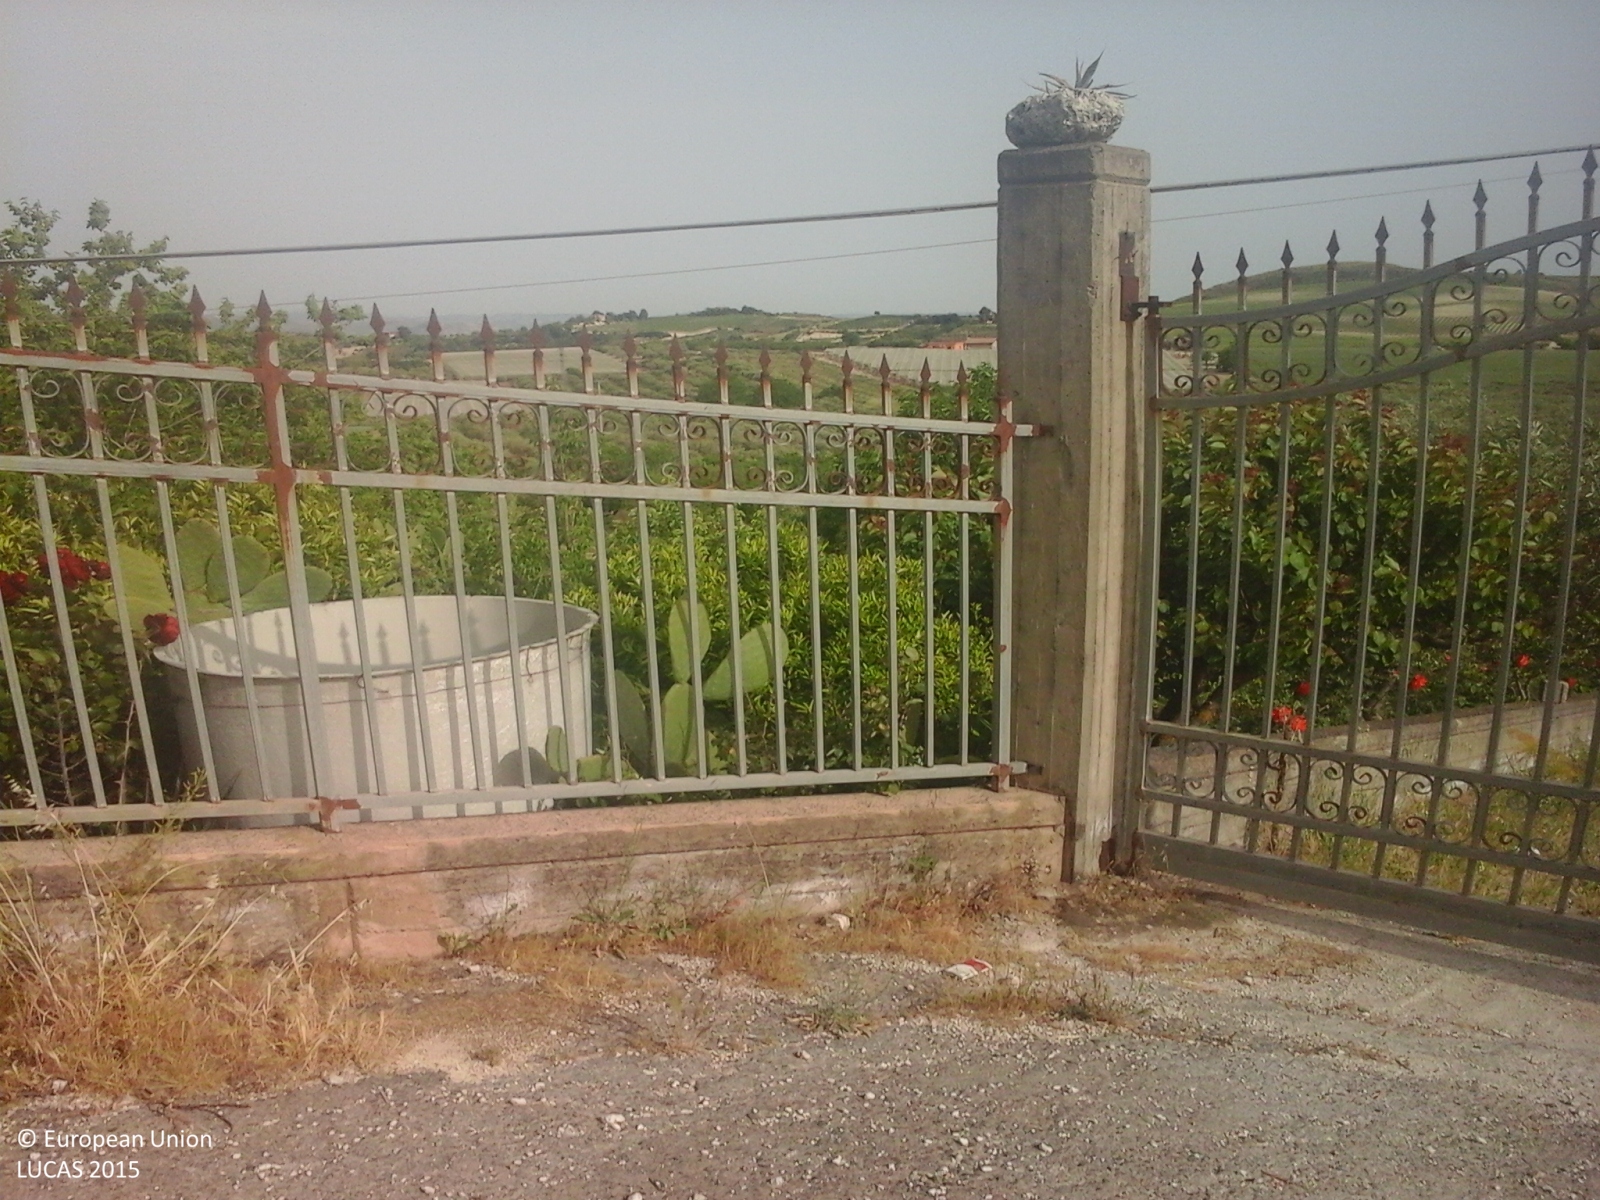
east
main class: Cropland
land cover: Olive groves
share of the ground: > 75 %
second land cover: Spontaneously vegetated surfaces
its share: > 75 %
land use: Agriculture (excluding fallow land and kitchen gardens)
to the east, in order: Olive groves; Spontaneously vegetated surfaces; Grass margins; Olive groves; Grass margins; Permanent crops (only in case pi); Grass margins; Permanent crops (only in case pi)
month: May
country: IT
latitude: 37.4660
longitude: 13.9388
